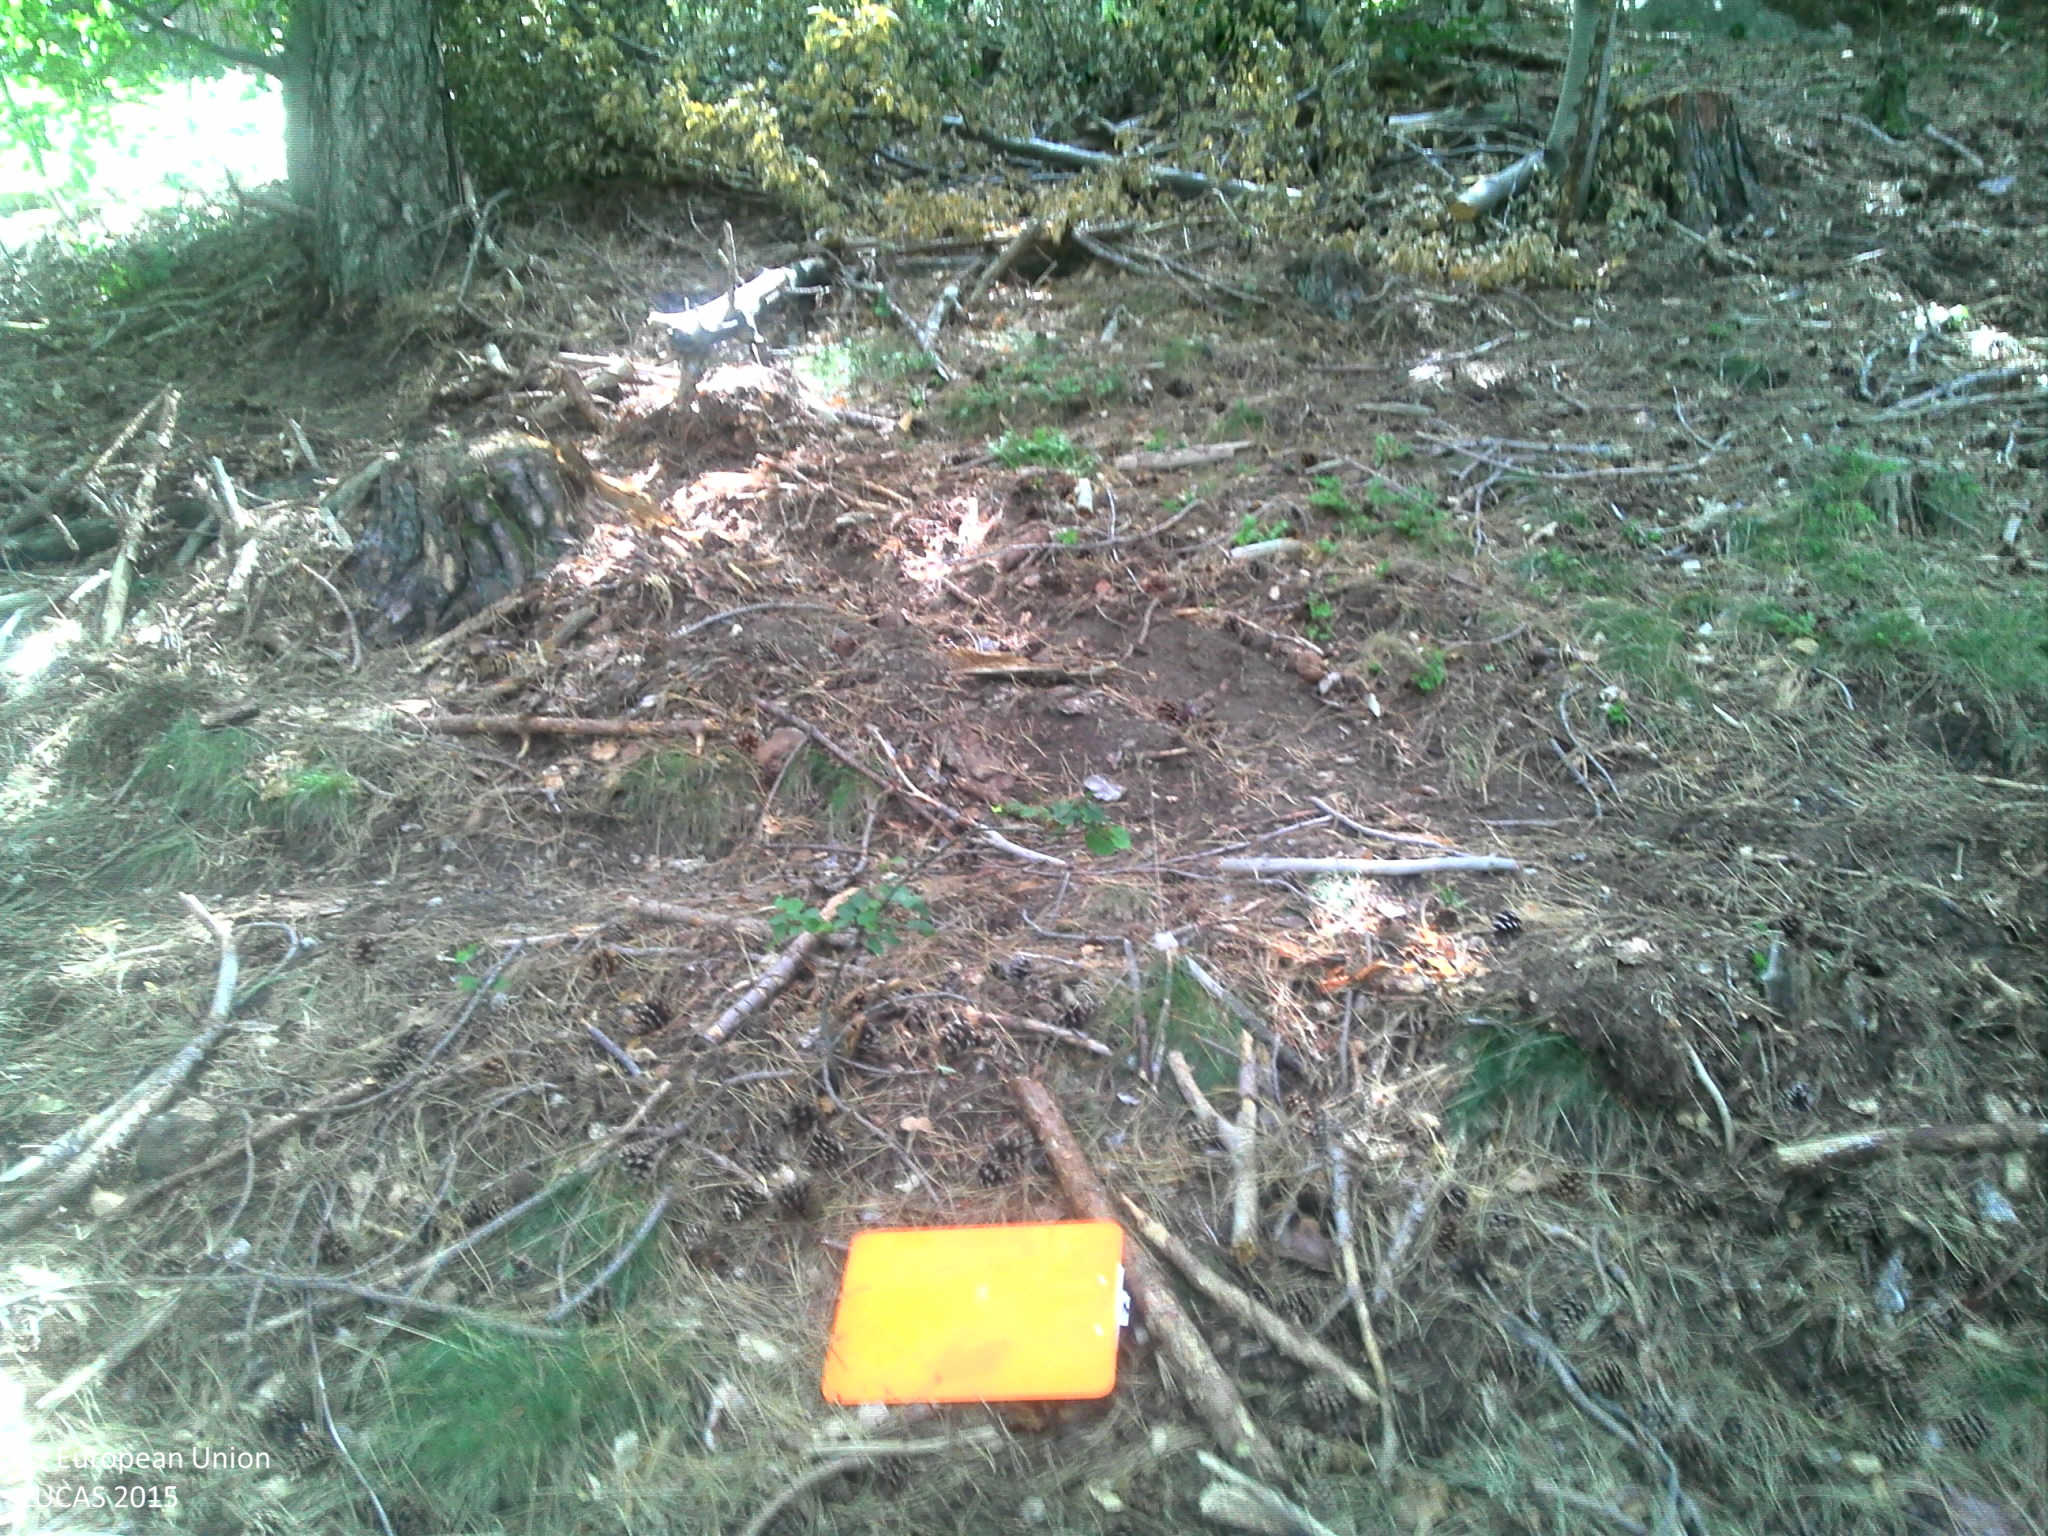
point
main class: Woodland
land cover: Spruce dominated mixed woodland
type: mountainous beech forest
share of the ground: > 75 %
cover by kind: coniferous forest trees 45 %, broadleaved forest trees 30 %, unconsolidated bare surface 15 %, herbaceous plants 10 %
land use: Forestry
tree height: > 5 m
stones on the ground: 10 - 25 %
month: August
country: FR
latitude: 44.7353
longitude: 4.2853
